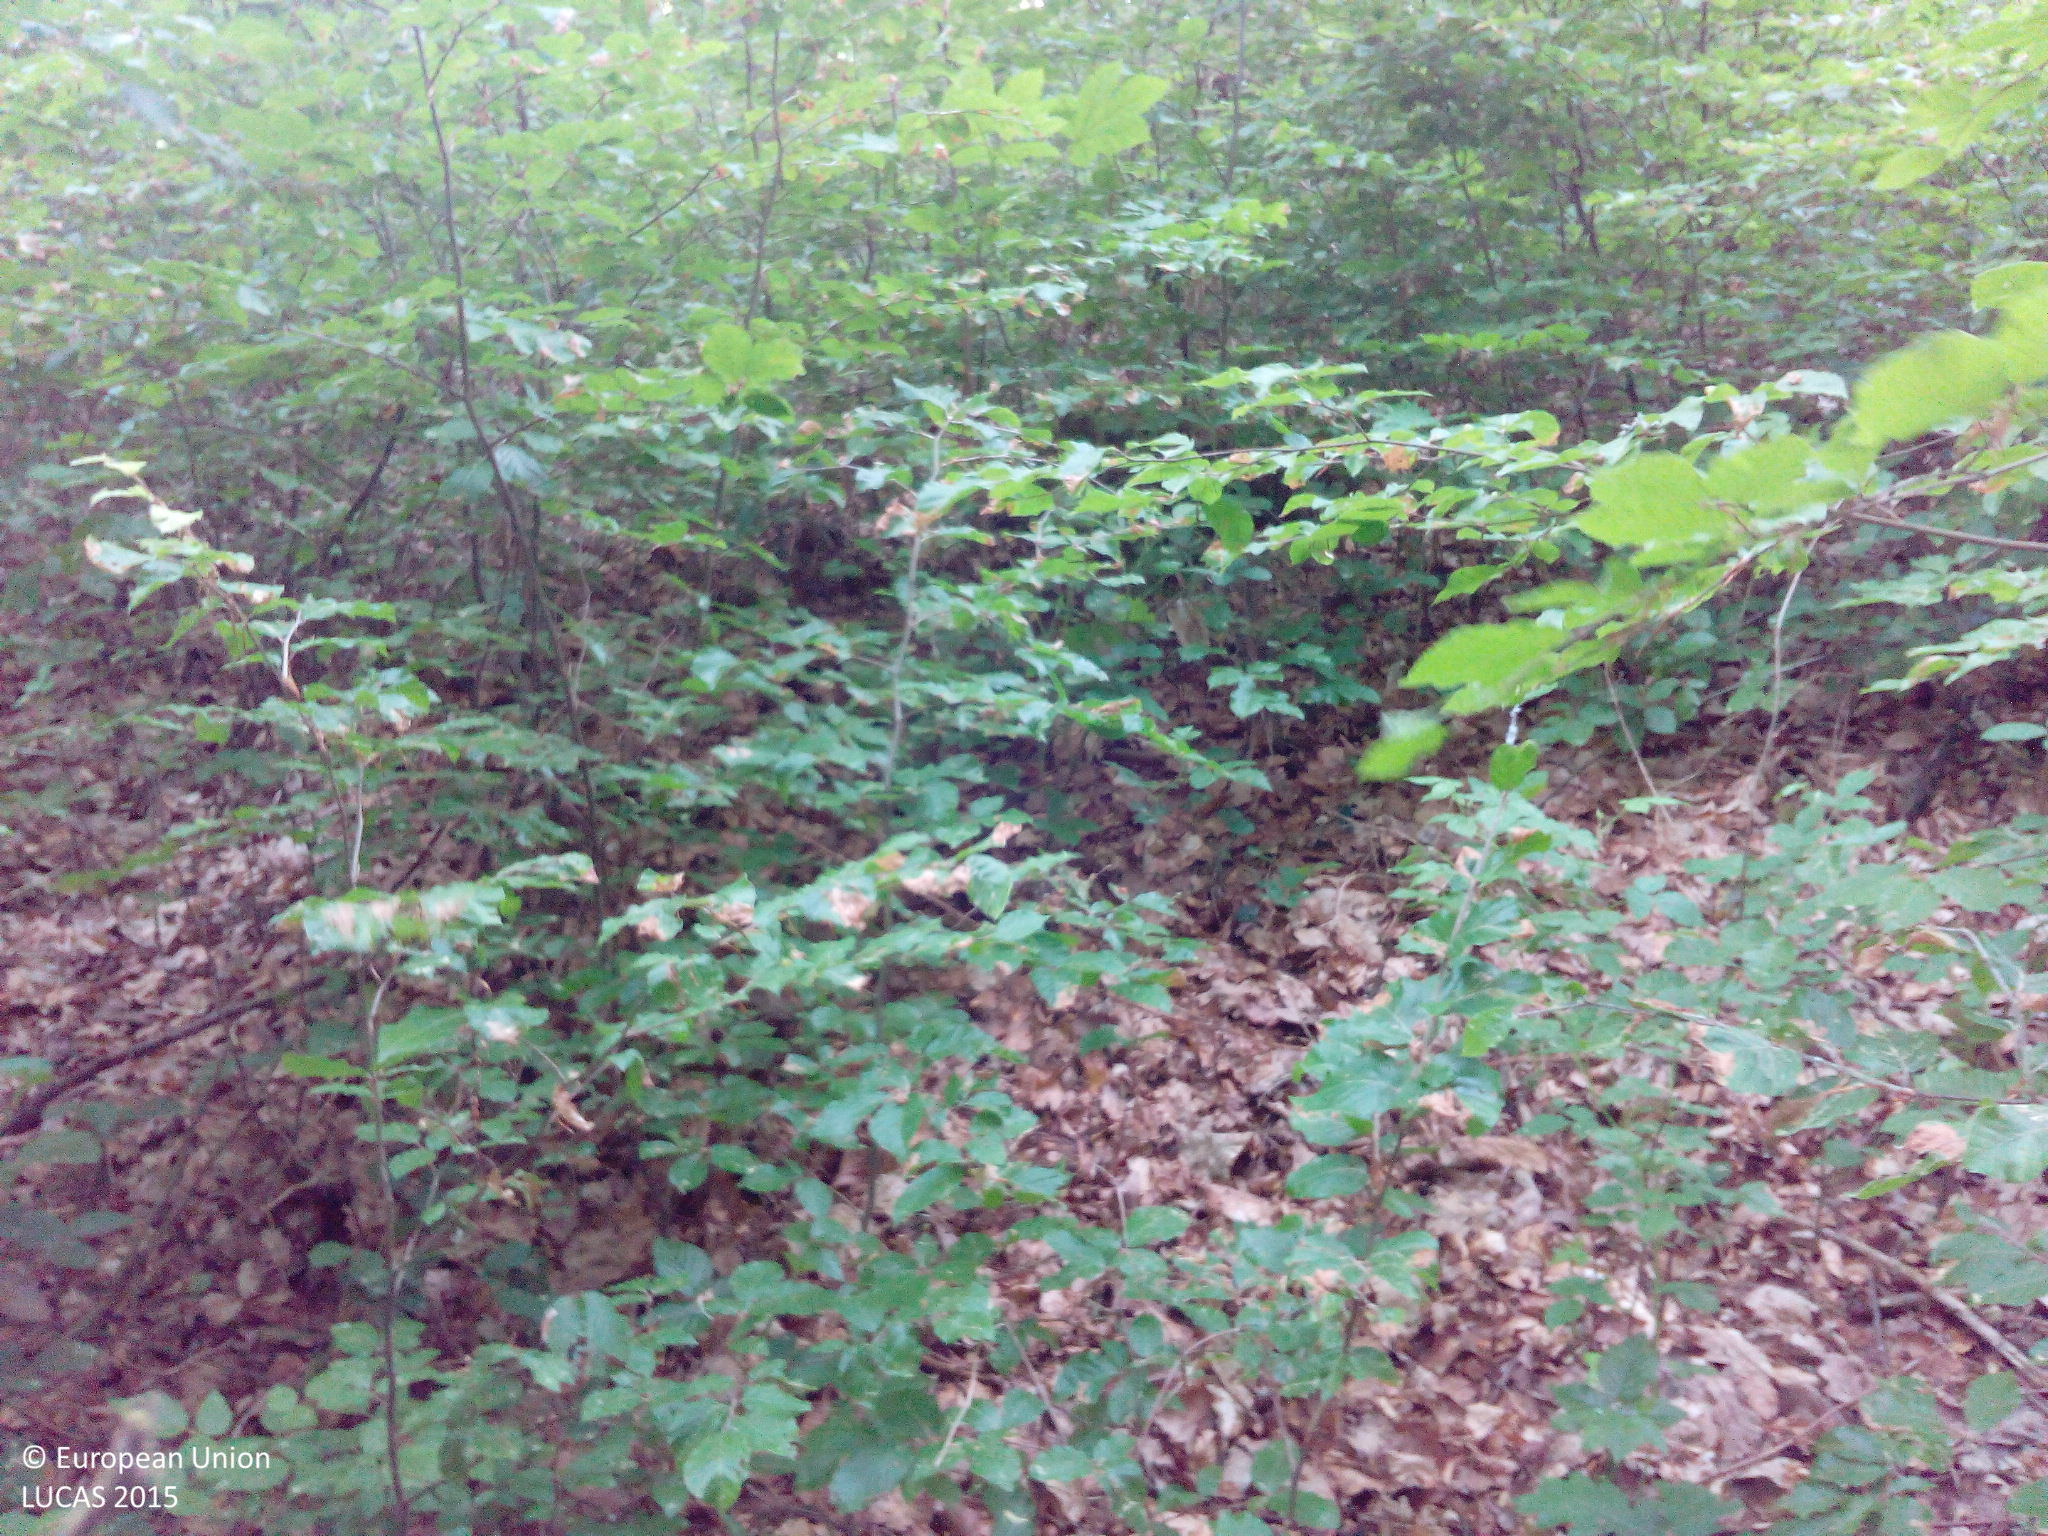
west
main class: Woodland
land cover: Spruce dominated mixed woodland
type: hemiboreal forest and nemoral coniferous forest and mixed broadleaved-coniferous forest
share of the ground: > 75 %
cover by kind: coniferous forest trees 50 %, broadleaved forest trees 30 %, unconsolidated bare surface 15 %, shrubs 5 %
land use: Forestry
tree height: > 5 m
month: May
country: DE
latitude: 49.1784
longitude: 11.9337
